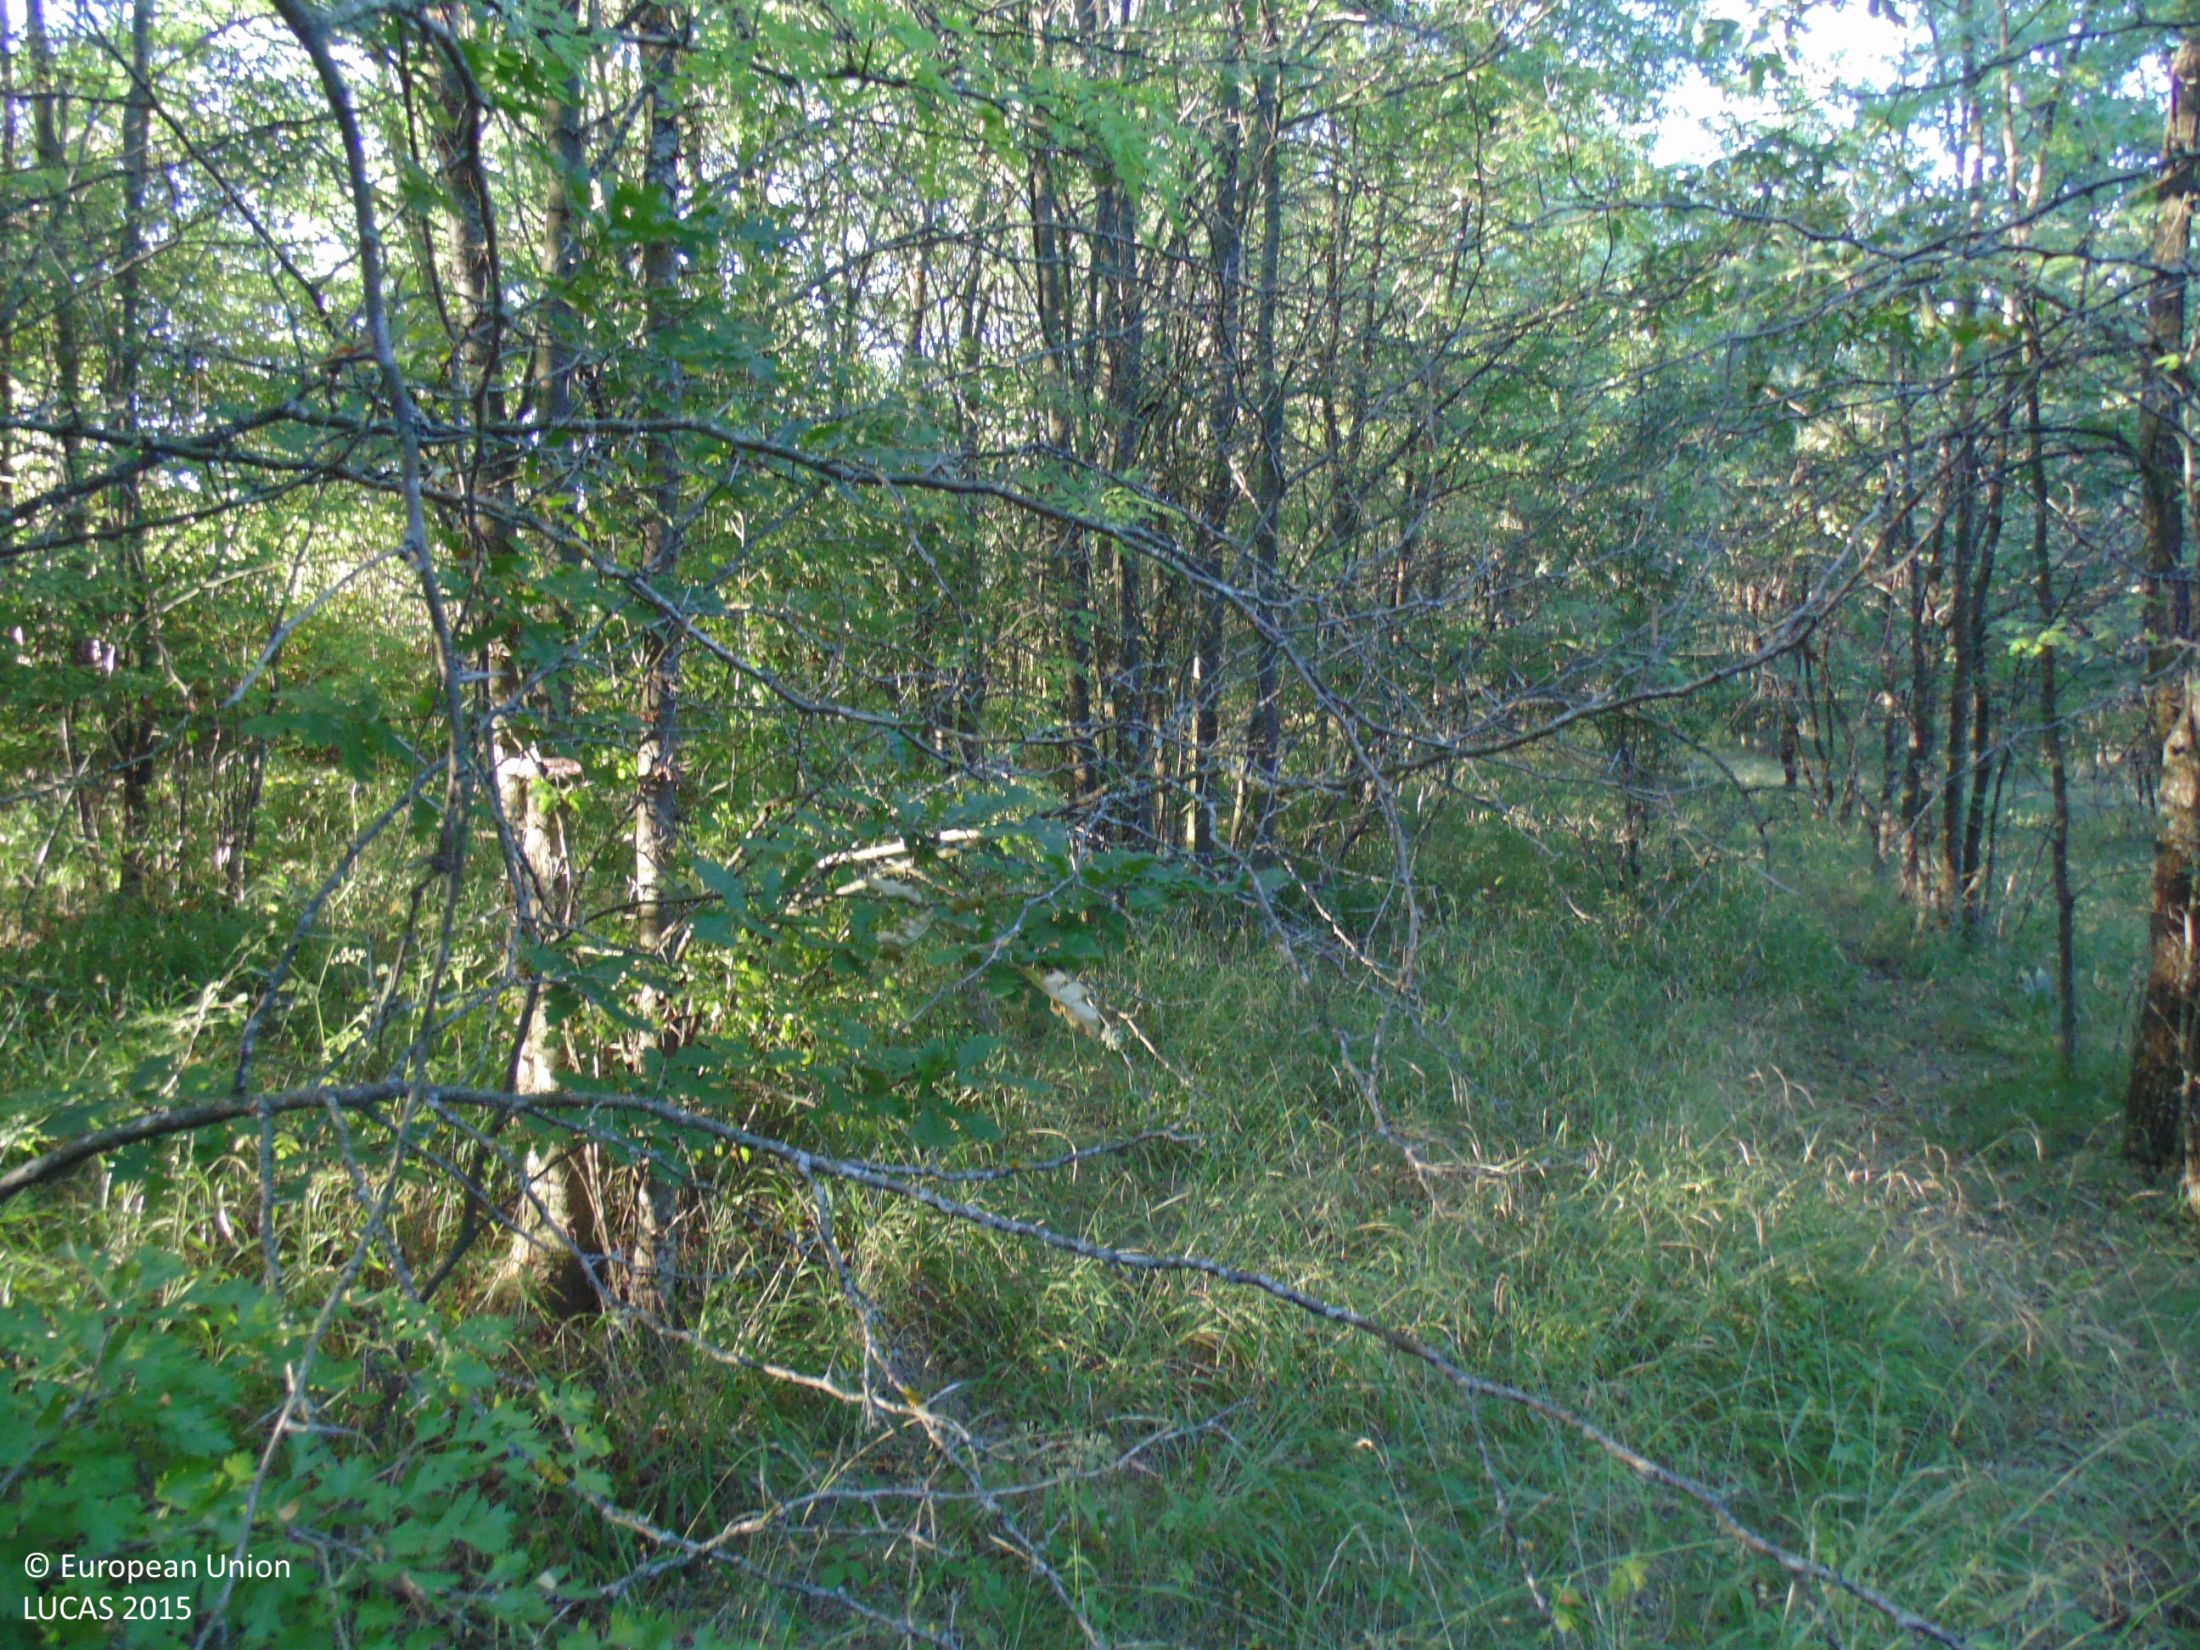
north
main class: Woodland
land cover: Broadleaved woodland
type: mesophytic deciduous forest
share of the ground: > 75 %
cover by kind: broadleaved forest trees 95 %, unconsolidated bare surface 5 %
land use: Forestry
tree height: > 5 m
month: September
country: BG
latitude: 43.7921
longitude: 27.2657
